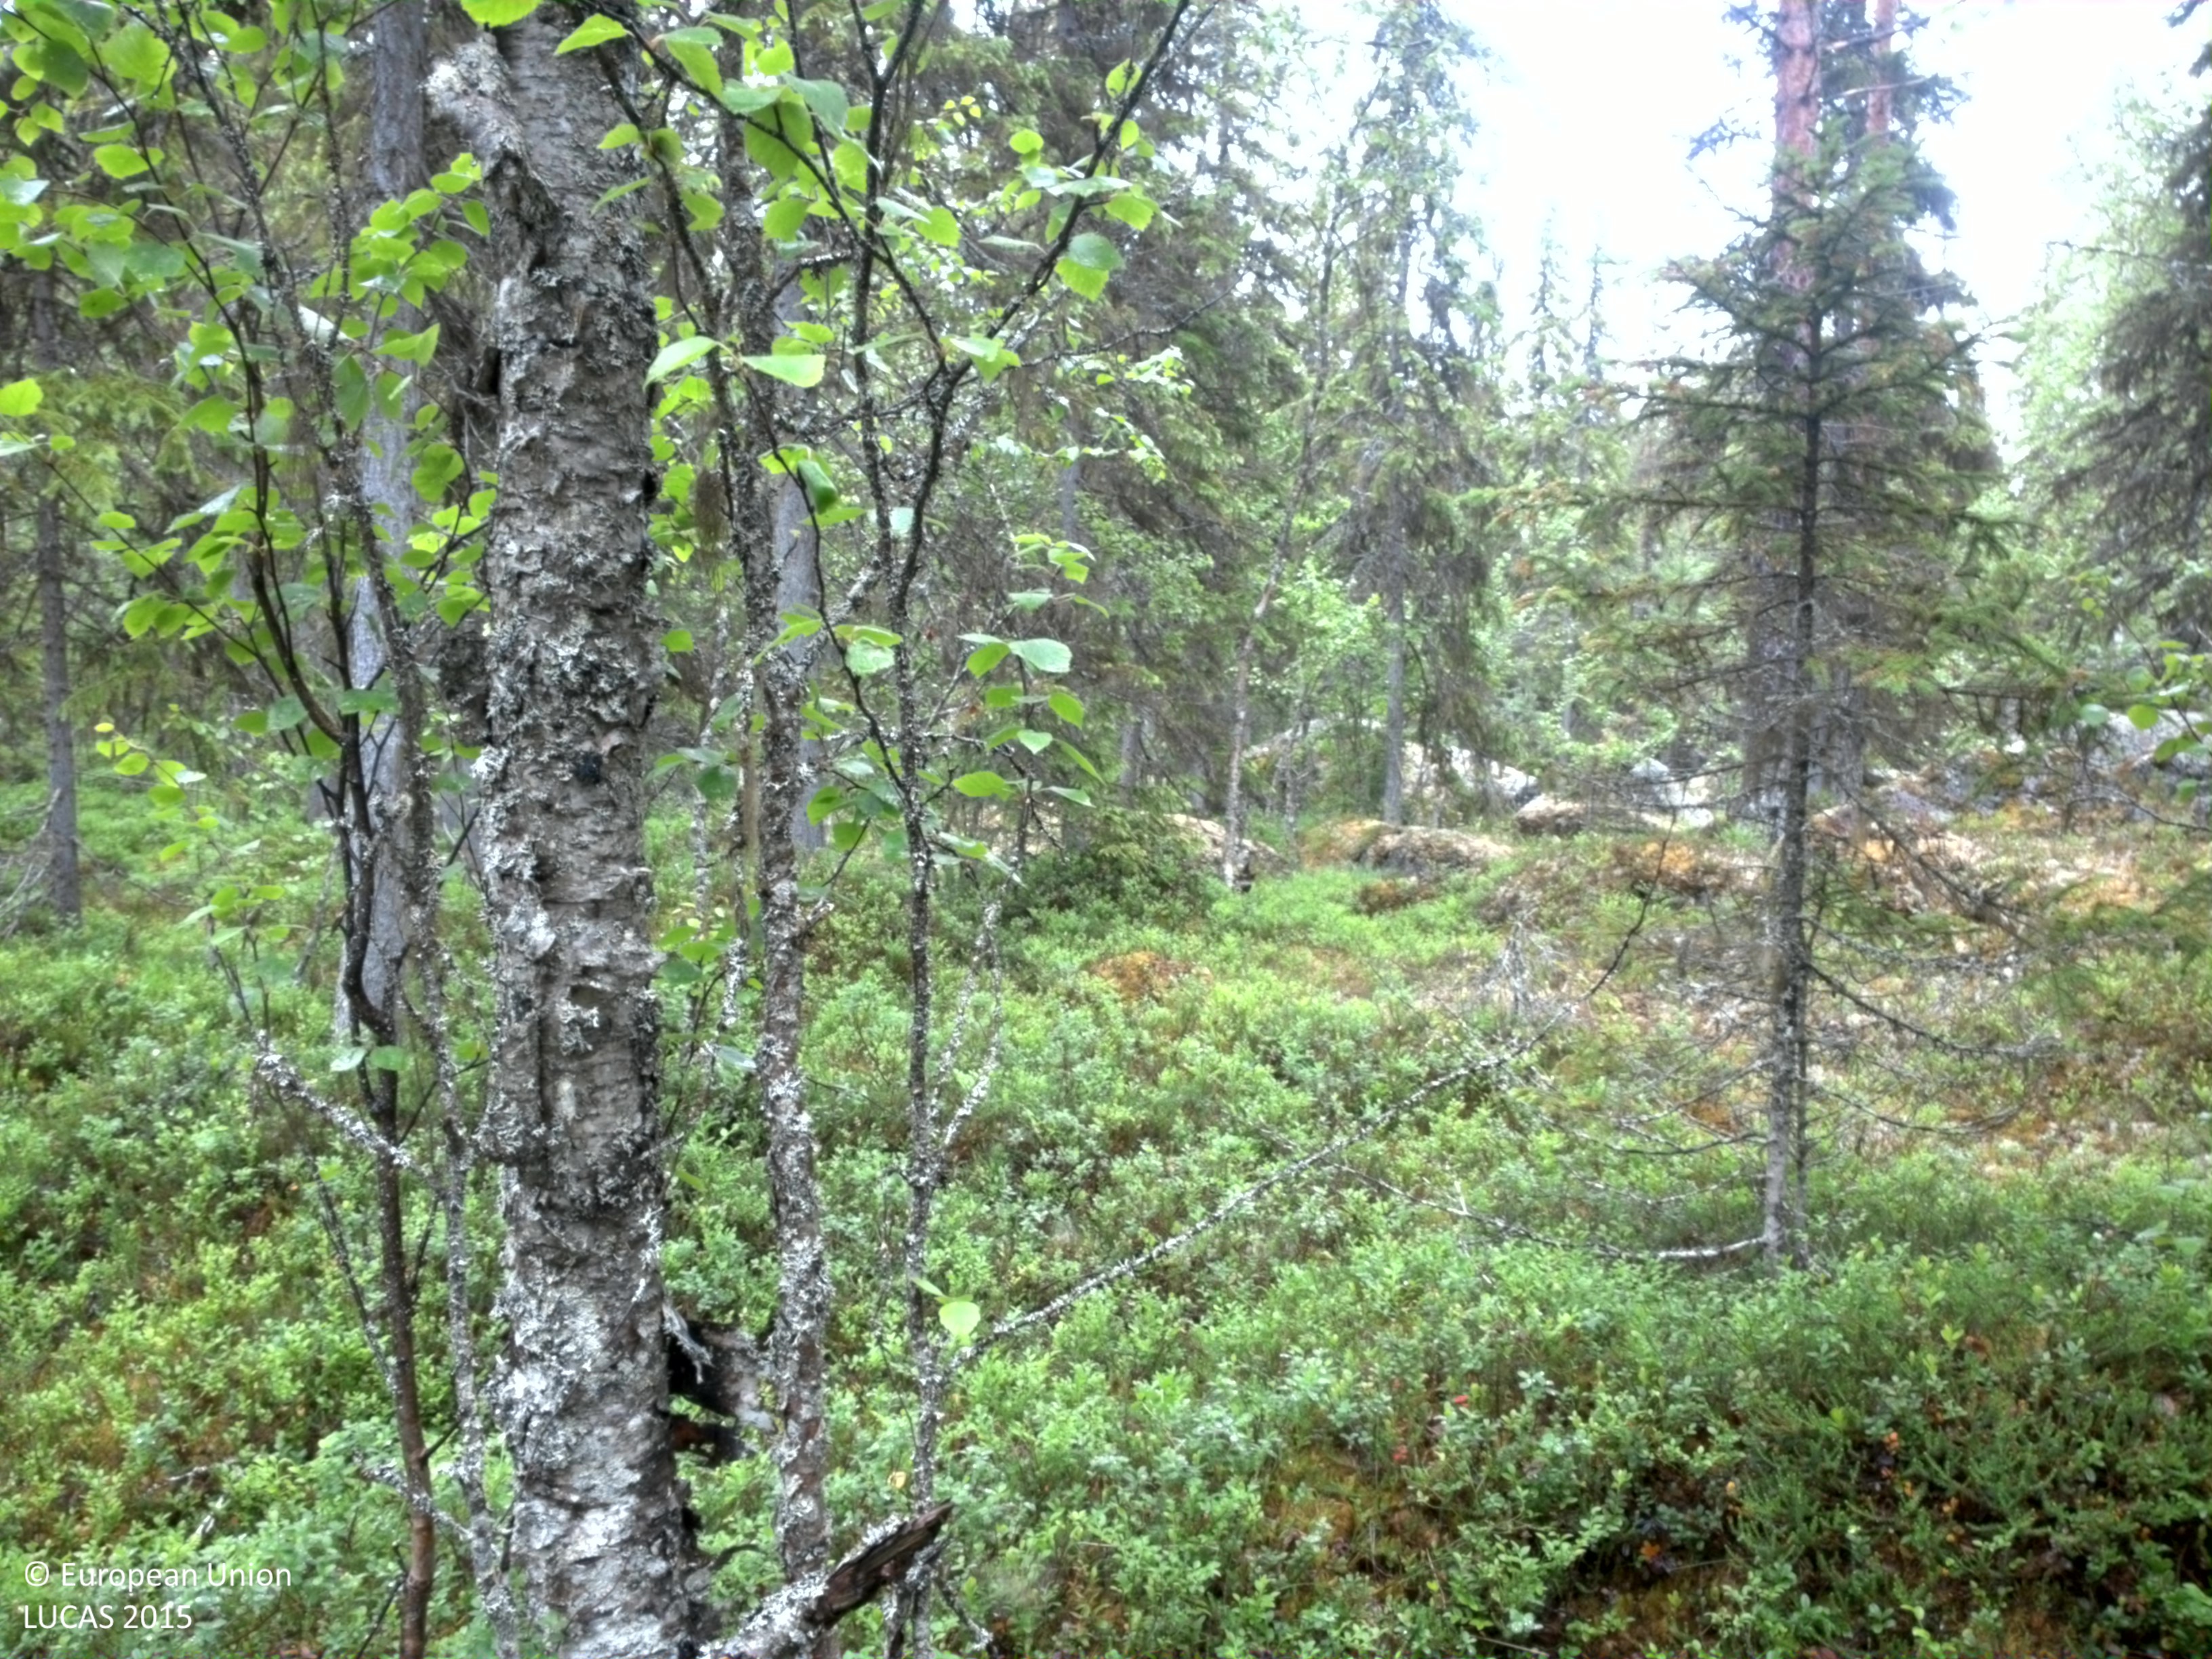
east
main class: Woodland
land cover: Other coniferous woodland
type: boreal forest
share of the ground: 25 - 50 %
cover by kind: coniferous forest trees 45 %, shrubs 40 %, lichens and mosses 10 %, broadleaved forest trees 5 %
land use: Forestry
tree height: > 5 m
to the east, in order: Other coniferous woodland; Spruce dominated coniferous woodland; Pine dominated coniferous woodland; Pine dominated mixed woodland
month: July
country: SE
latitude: 64.6007
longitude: 18.2626
